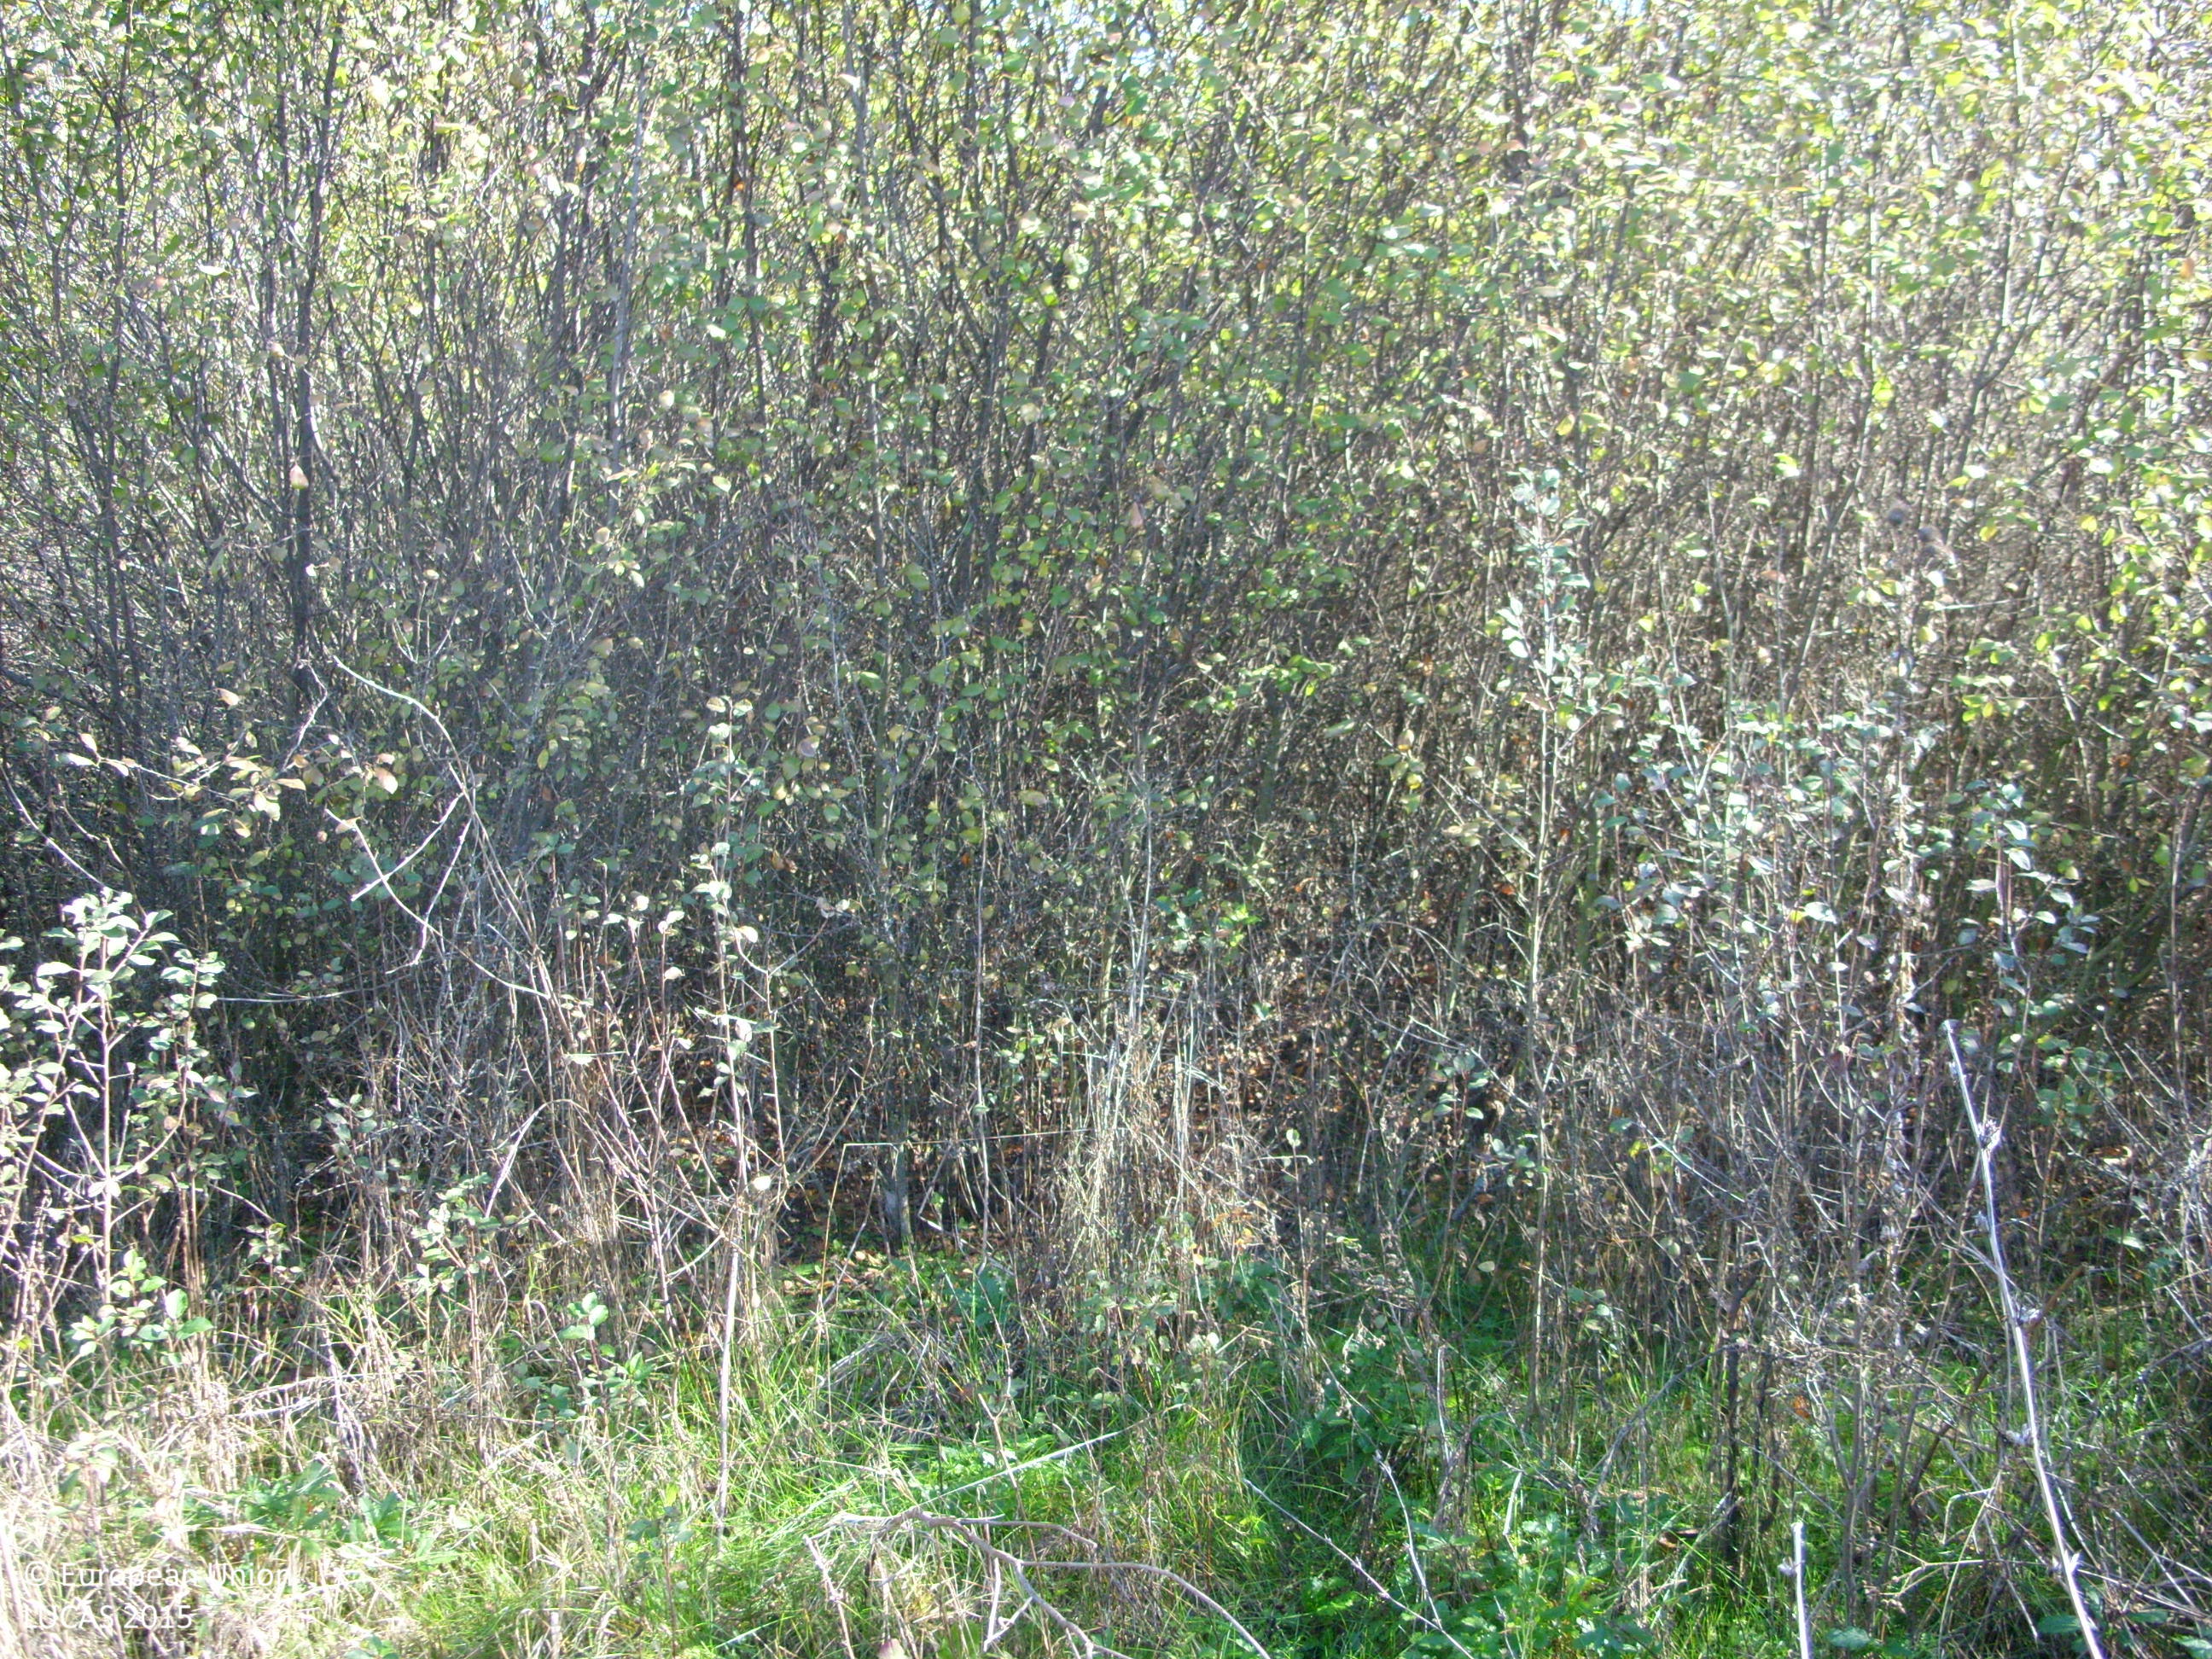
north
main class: Shrubland
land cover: Shrubland with sparse tree cover
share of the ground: > 75 %
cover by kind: shrubs 80 %, herbaceous plants 15 %, broadleaved forest trees 5 %
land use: Abandoned areas
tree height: < 5 m
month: November
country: BG
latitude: 42.3226
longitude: 24.9706
